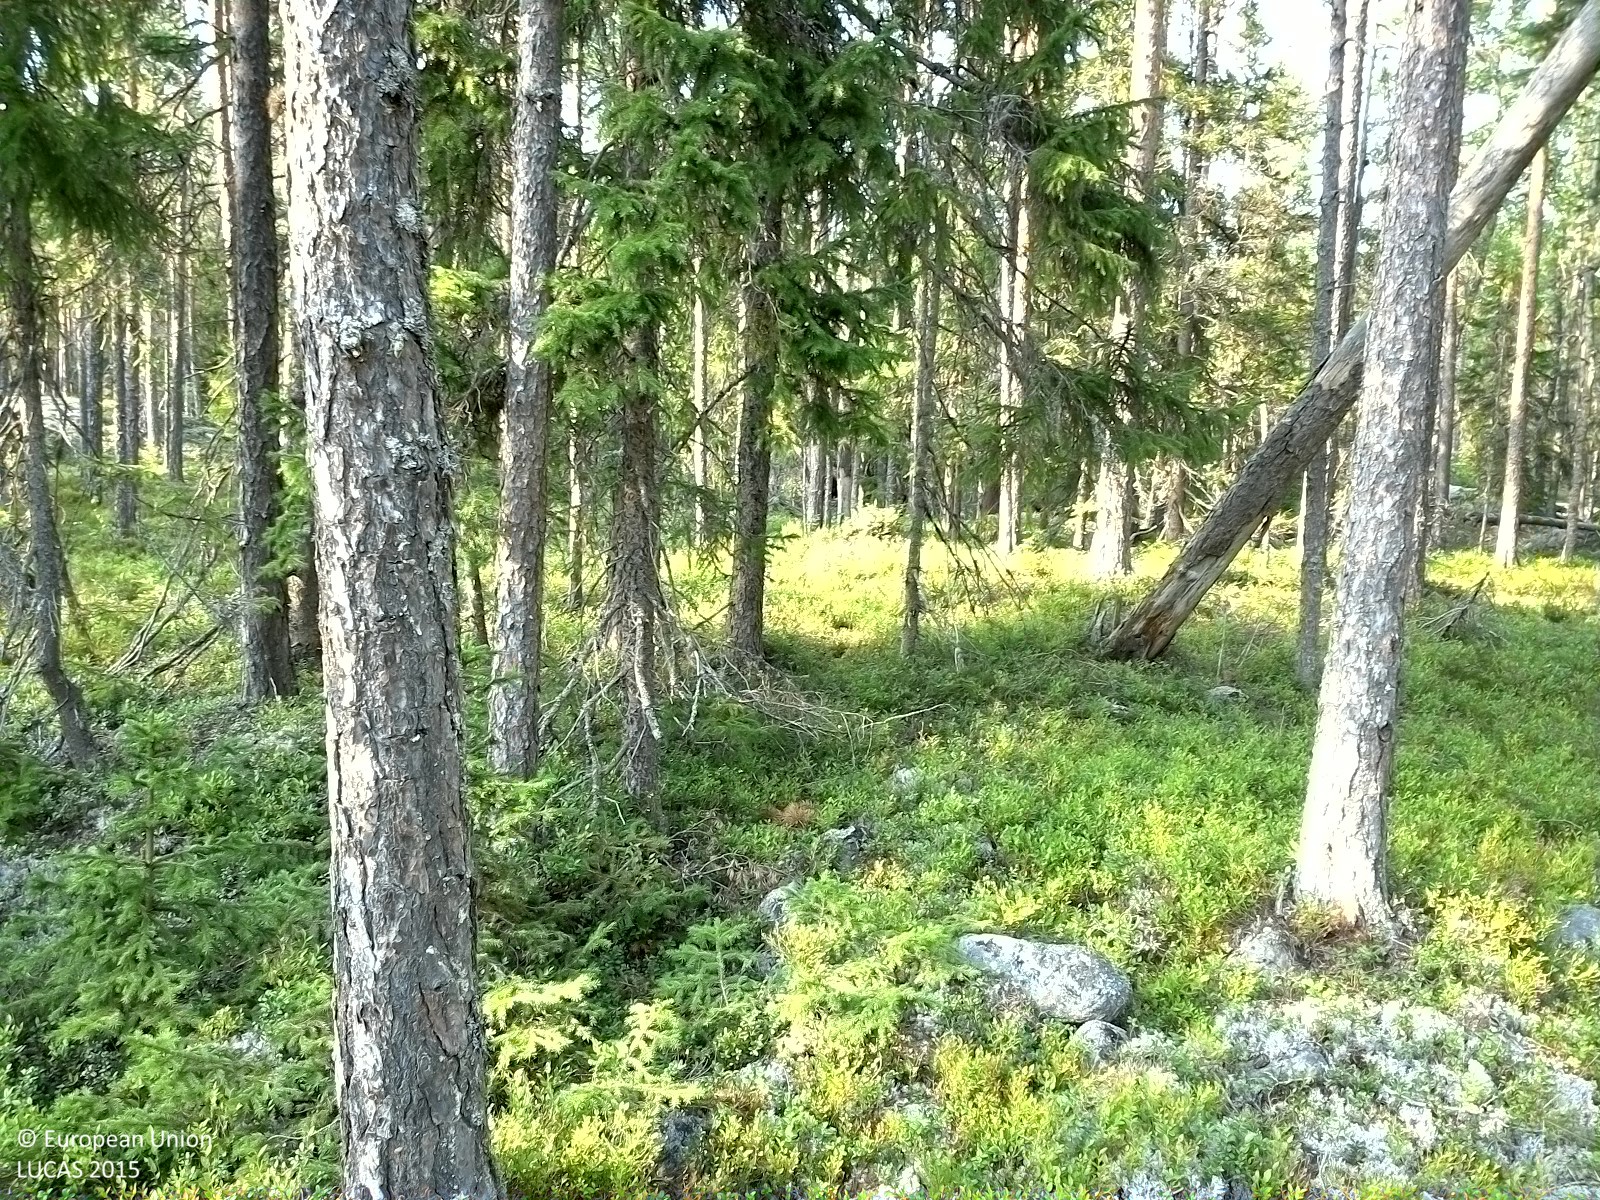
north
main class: Woodland
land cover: Pine dominated coniferous woodland
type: boreal forest
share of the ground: 25 - 50 %
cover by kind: lichens and mosses 40 %, coniferous forest trees 35 %, shrubs 25 %
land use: Forestry
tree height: > 5 m
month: August
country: SE
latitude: 62.3710
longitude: 17.5000
